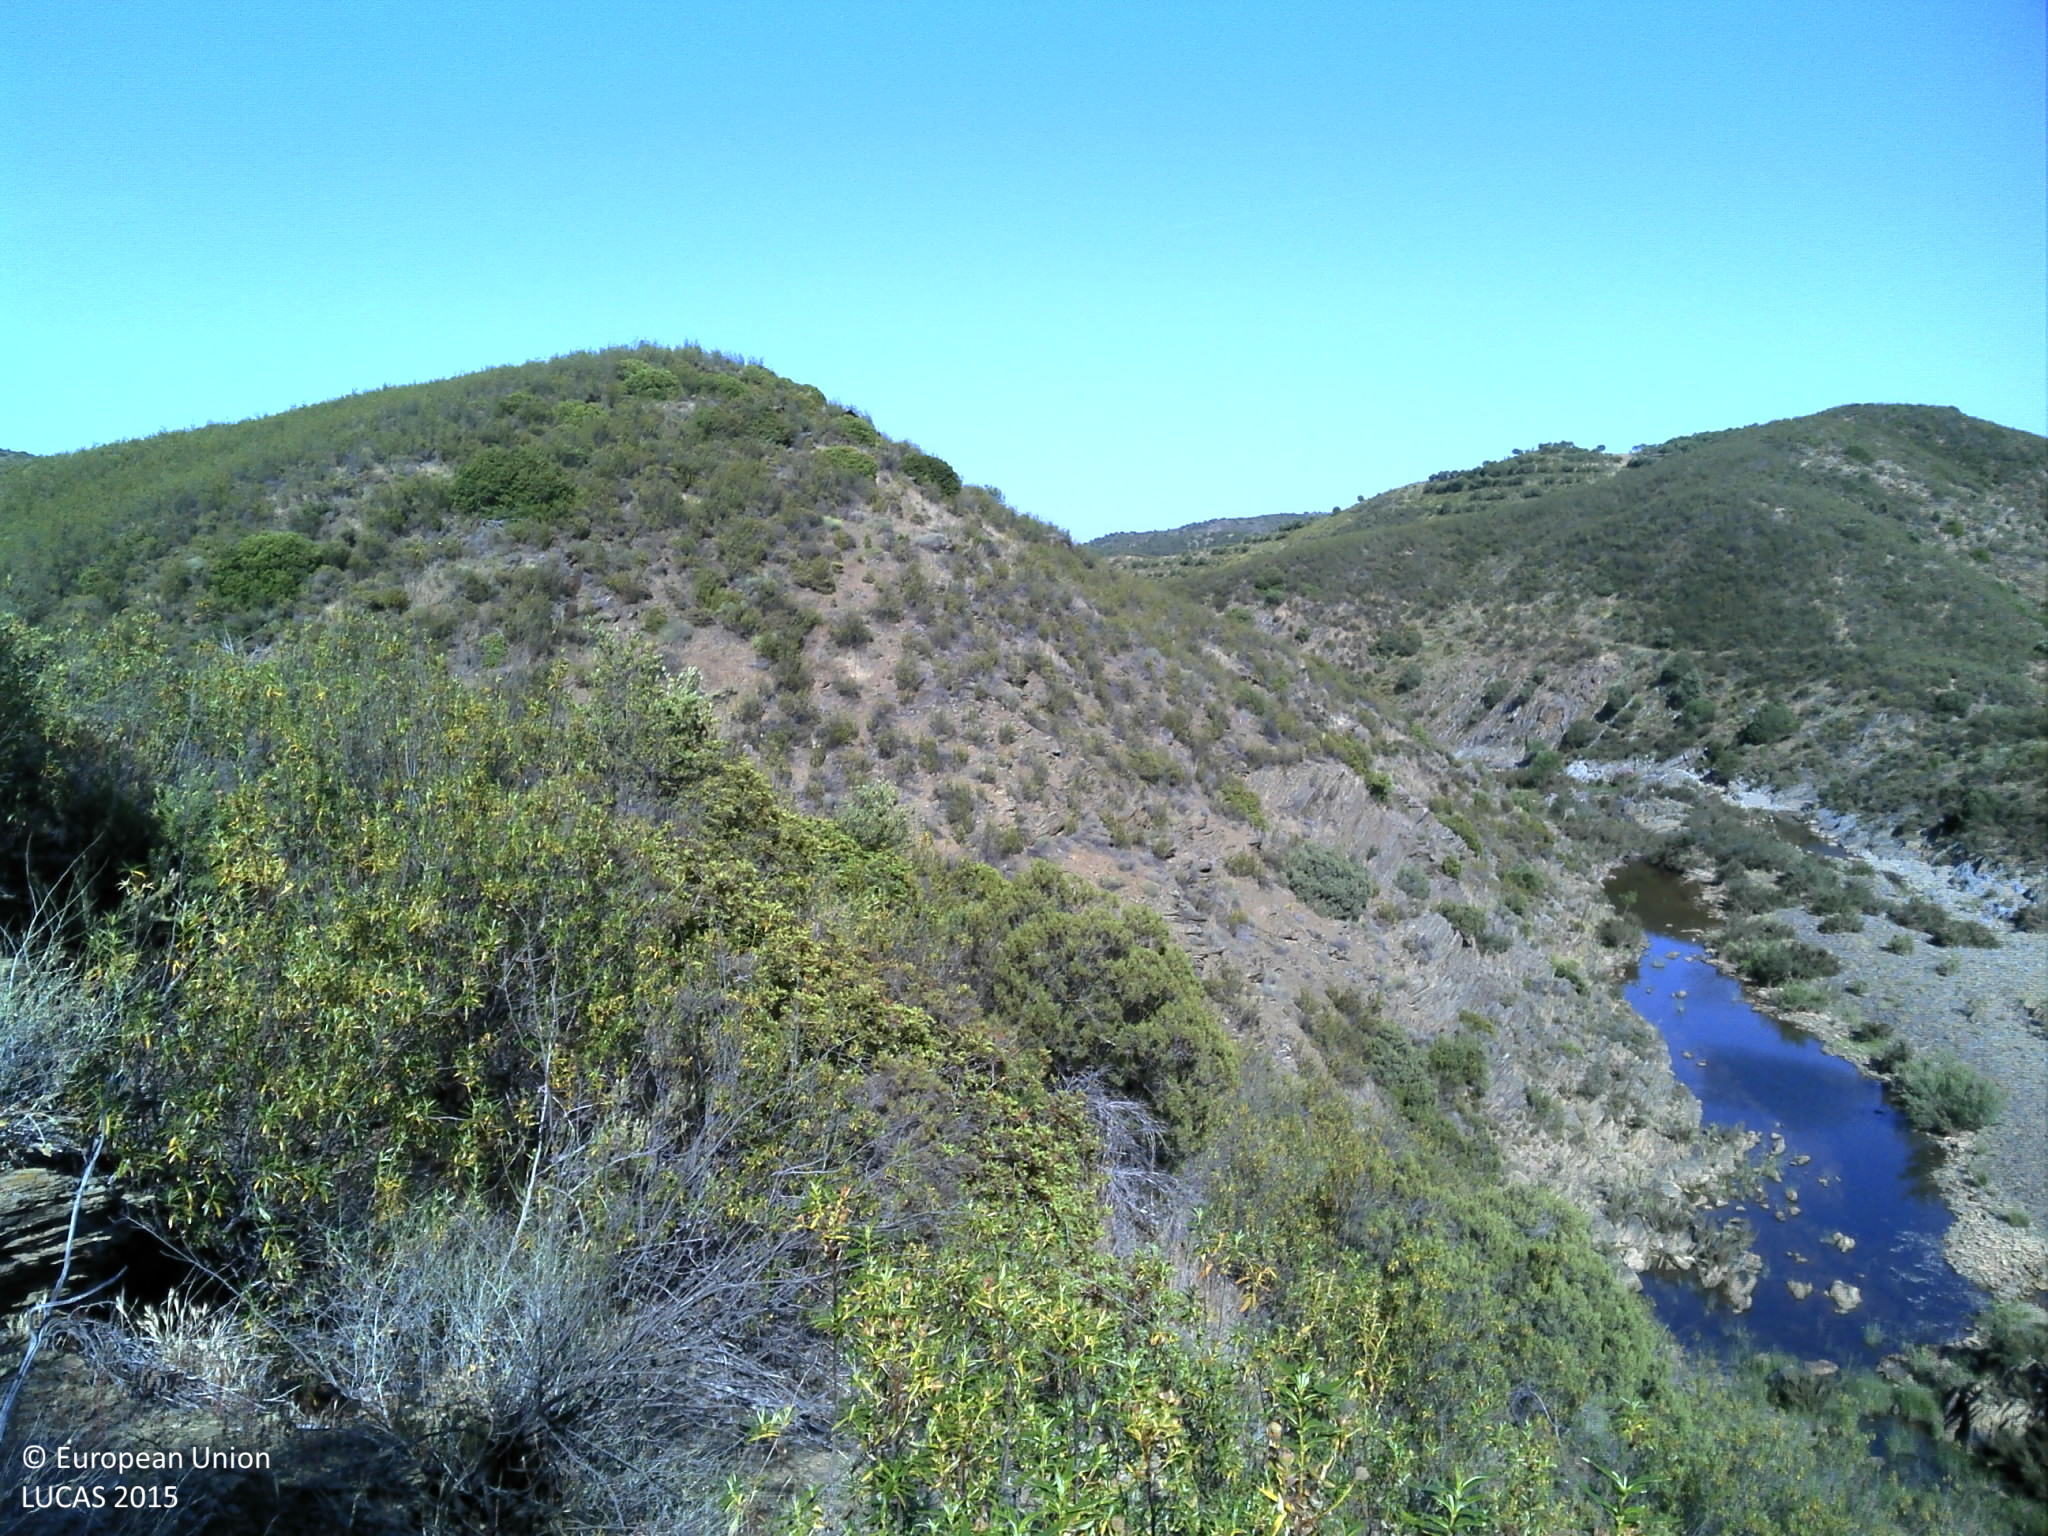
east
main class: Shrubland
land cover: Shrubland without tree cover
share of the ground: > 75 %
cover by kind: shrubs 95 %, unconsolidated bare surface 5 %
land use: Semi-natural and natural areas not in use
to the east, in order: Shrubland without tree cover; Rivers and streams; Shrubland without tree cover
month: May
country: PT
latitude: 37.5237
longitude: -7.5608
